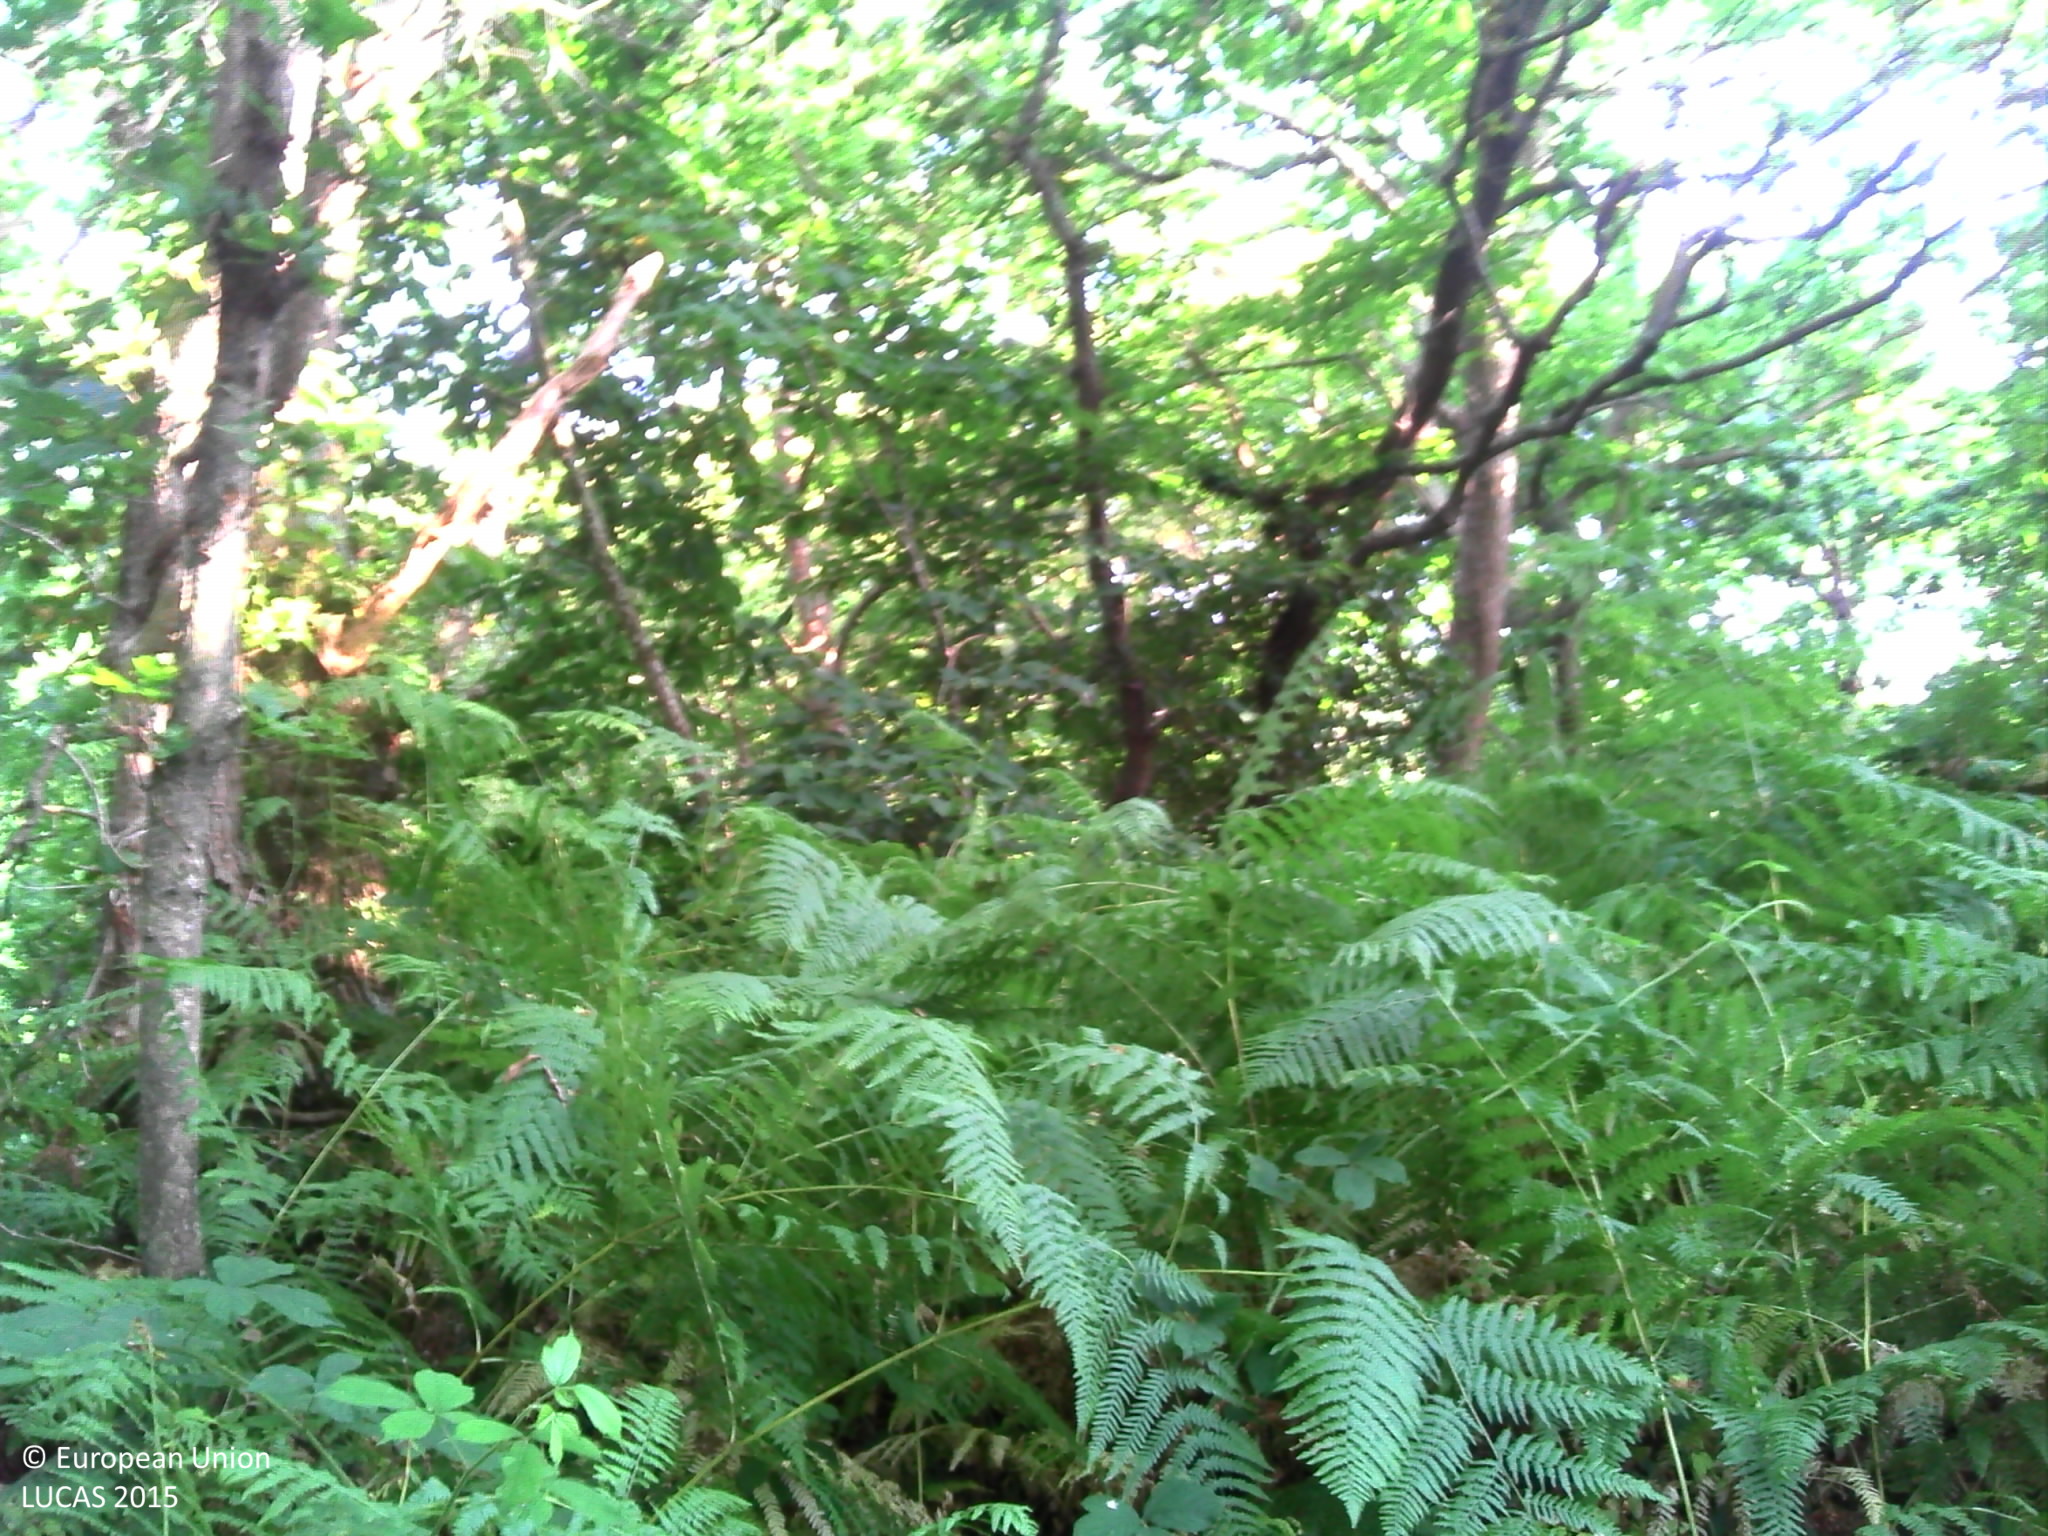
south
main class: Woodland
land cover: Broadleaved woodland
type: acidophilous oak and oak-birch forest
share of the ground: > 75 %
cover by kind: broadleaved forest trees 65 %, herbaceous plants 20 %, unconsolidated bare surface 10 %, lichens and mosses 5 %
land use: Forestry
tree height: > 5 m
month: July
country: FR
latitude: 48.8120
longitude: -3.4933
